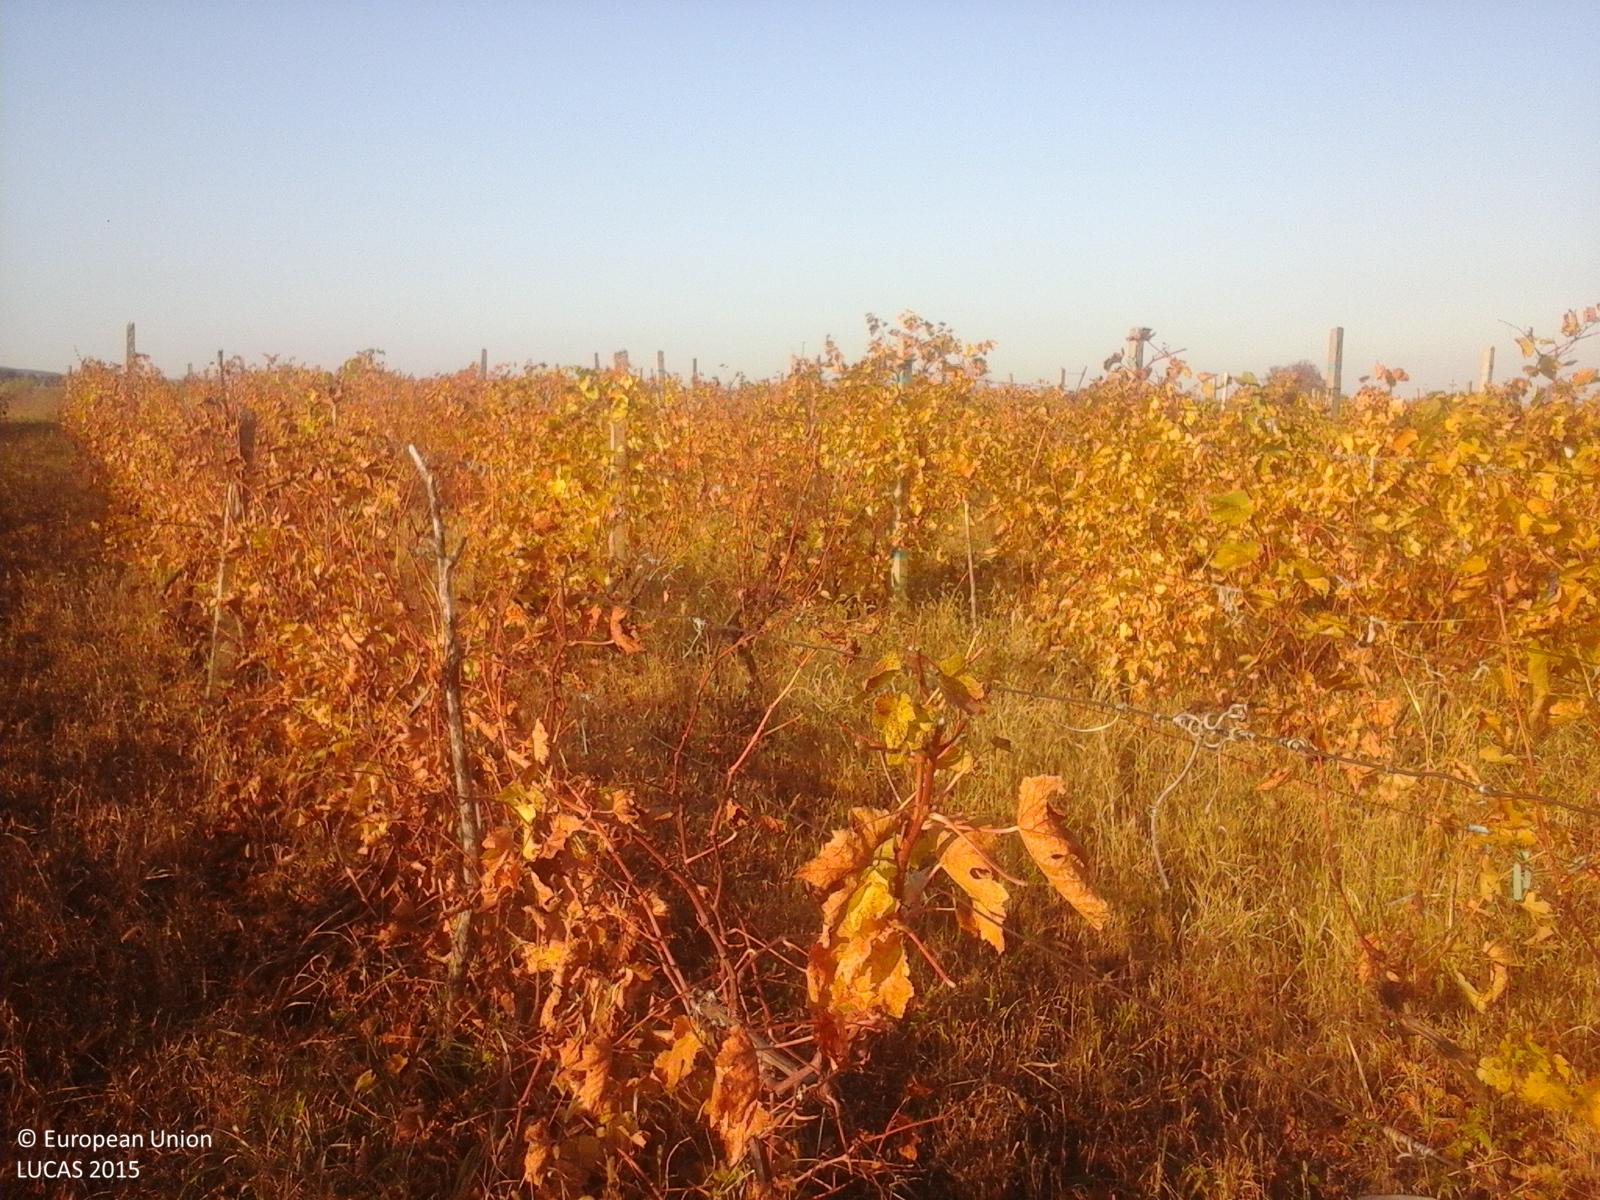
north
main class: Cropland
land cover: Vineyards
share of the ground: > 75 %
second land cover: Other bare soil
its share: > 75 %
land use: Agriculture (excluding fallow land and kitchen gardens)
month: October
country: RO
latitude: 45.4857
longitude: 27.0415
